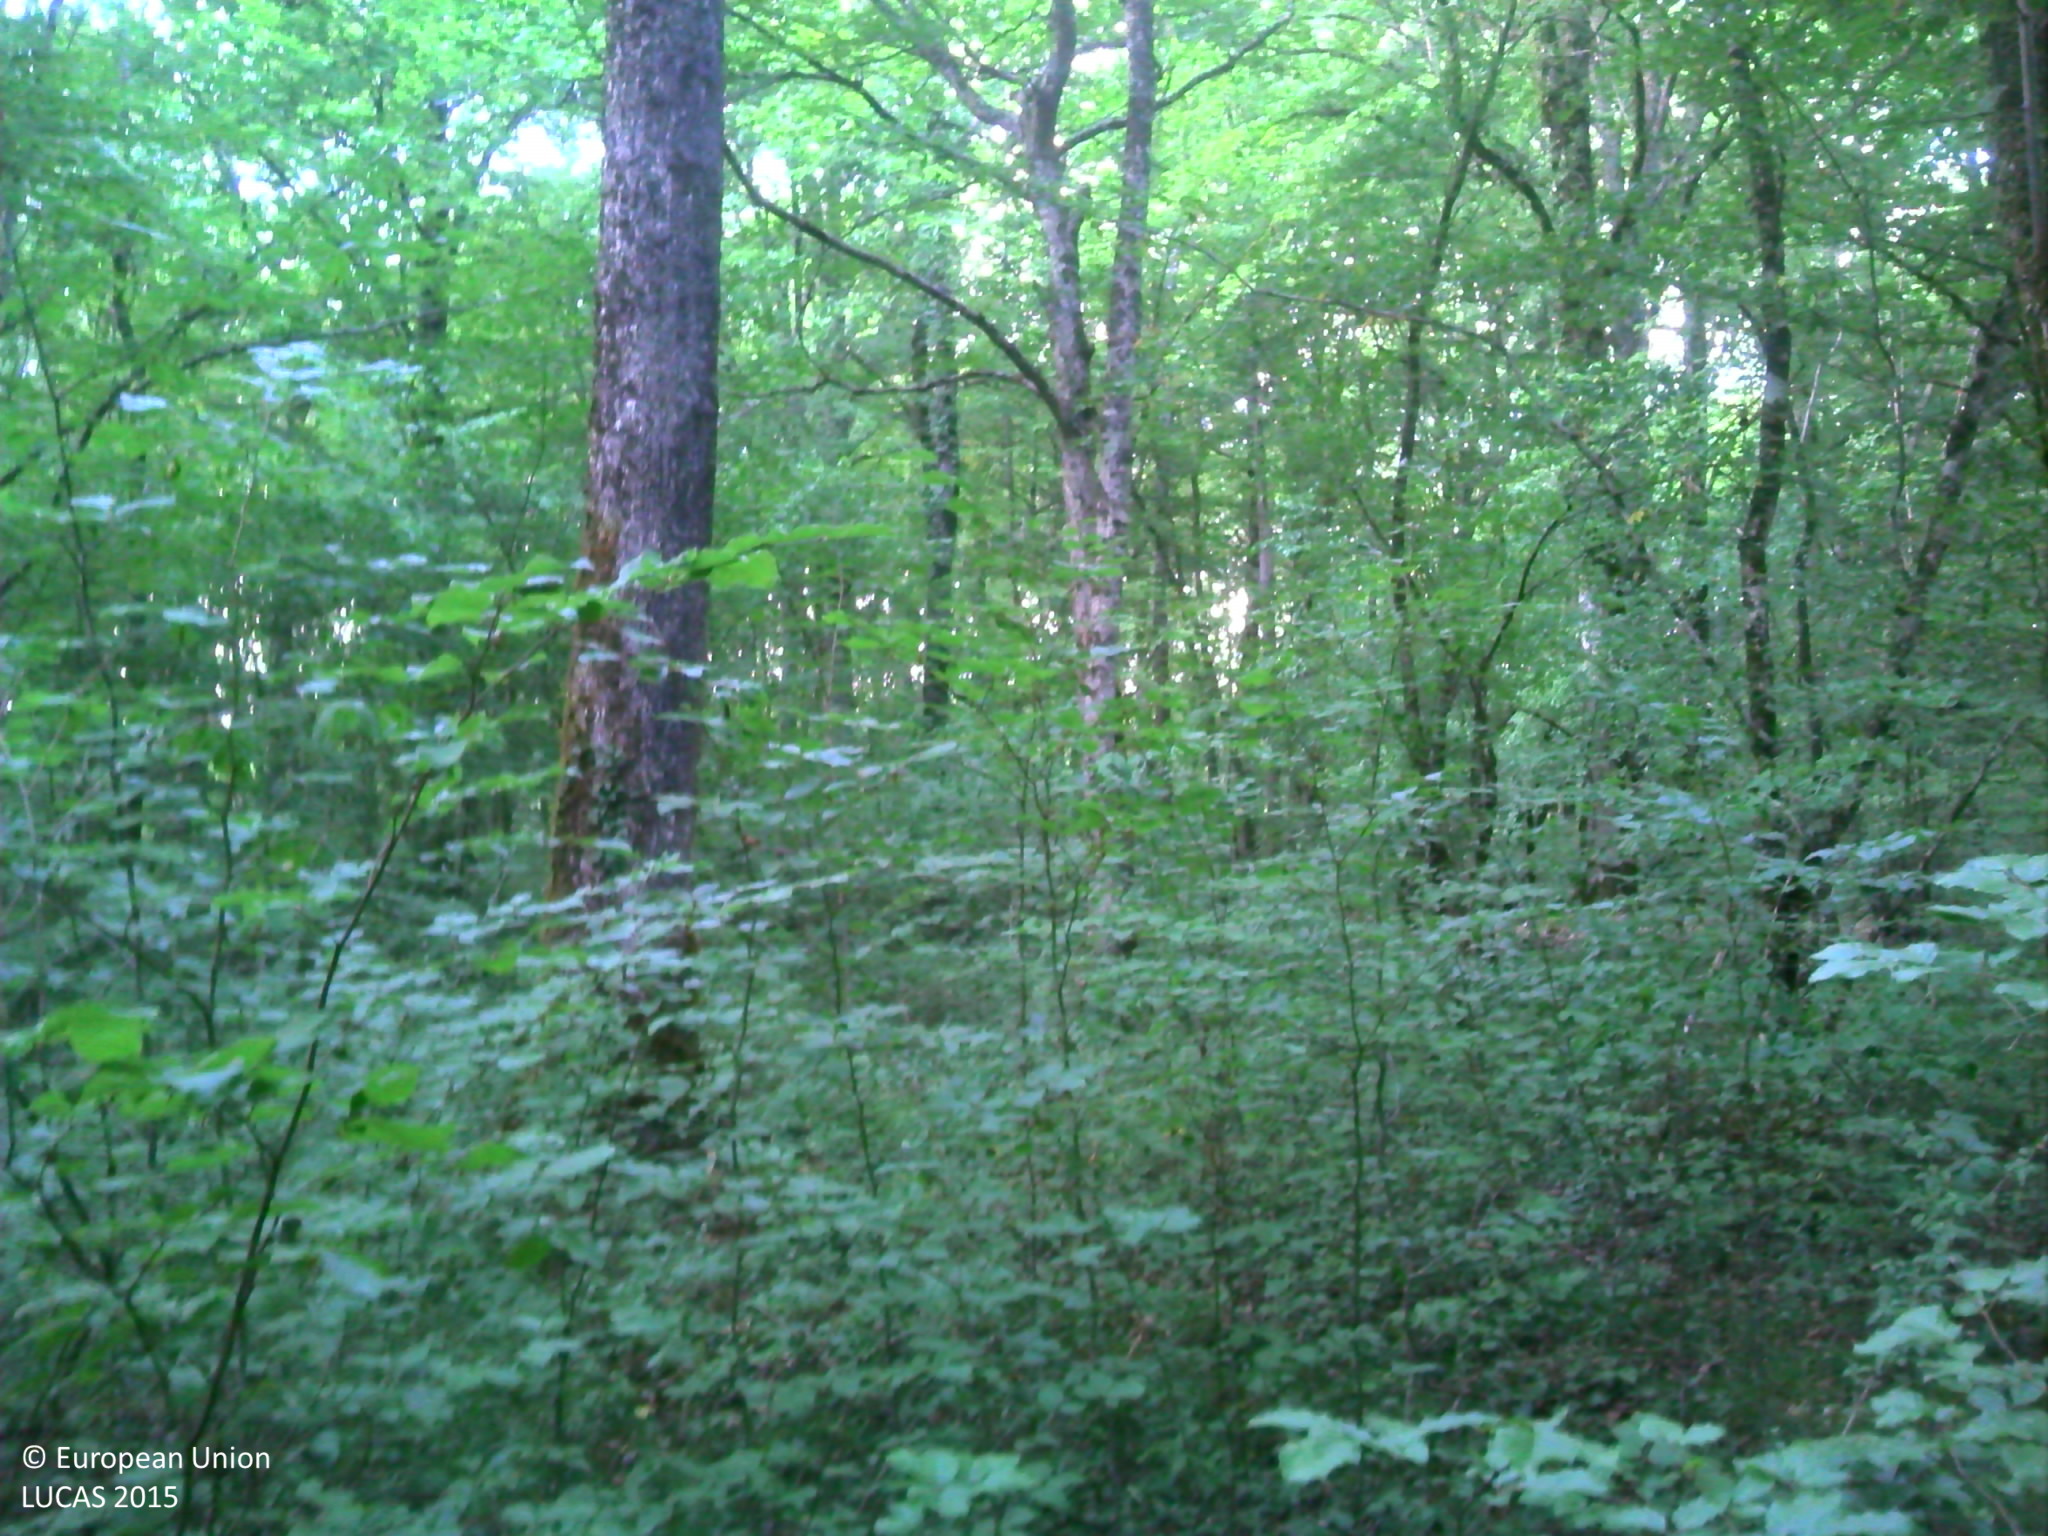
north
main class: Woodland
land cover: Broadleaved woodland
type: acidophilous oak and oak-birch forest
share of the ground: > 75 %
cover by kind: broadleaved forest trees 85 %, herbaceous plants 10 %, lichens and mosses 5 %
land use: Forestry
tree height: > 5 m
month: July
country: FR
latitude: 47.8751
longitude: 4.9854
